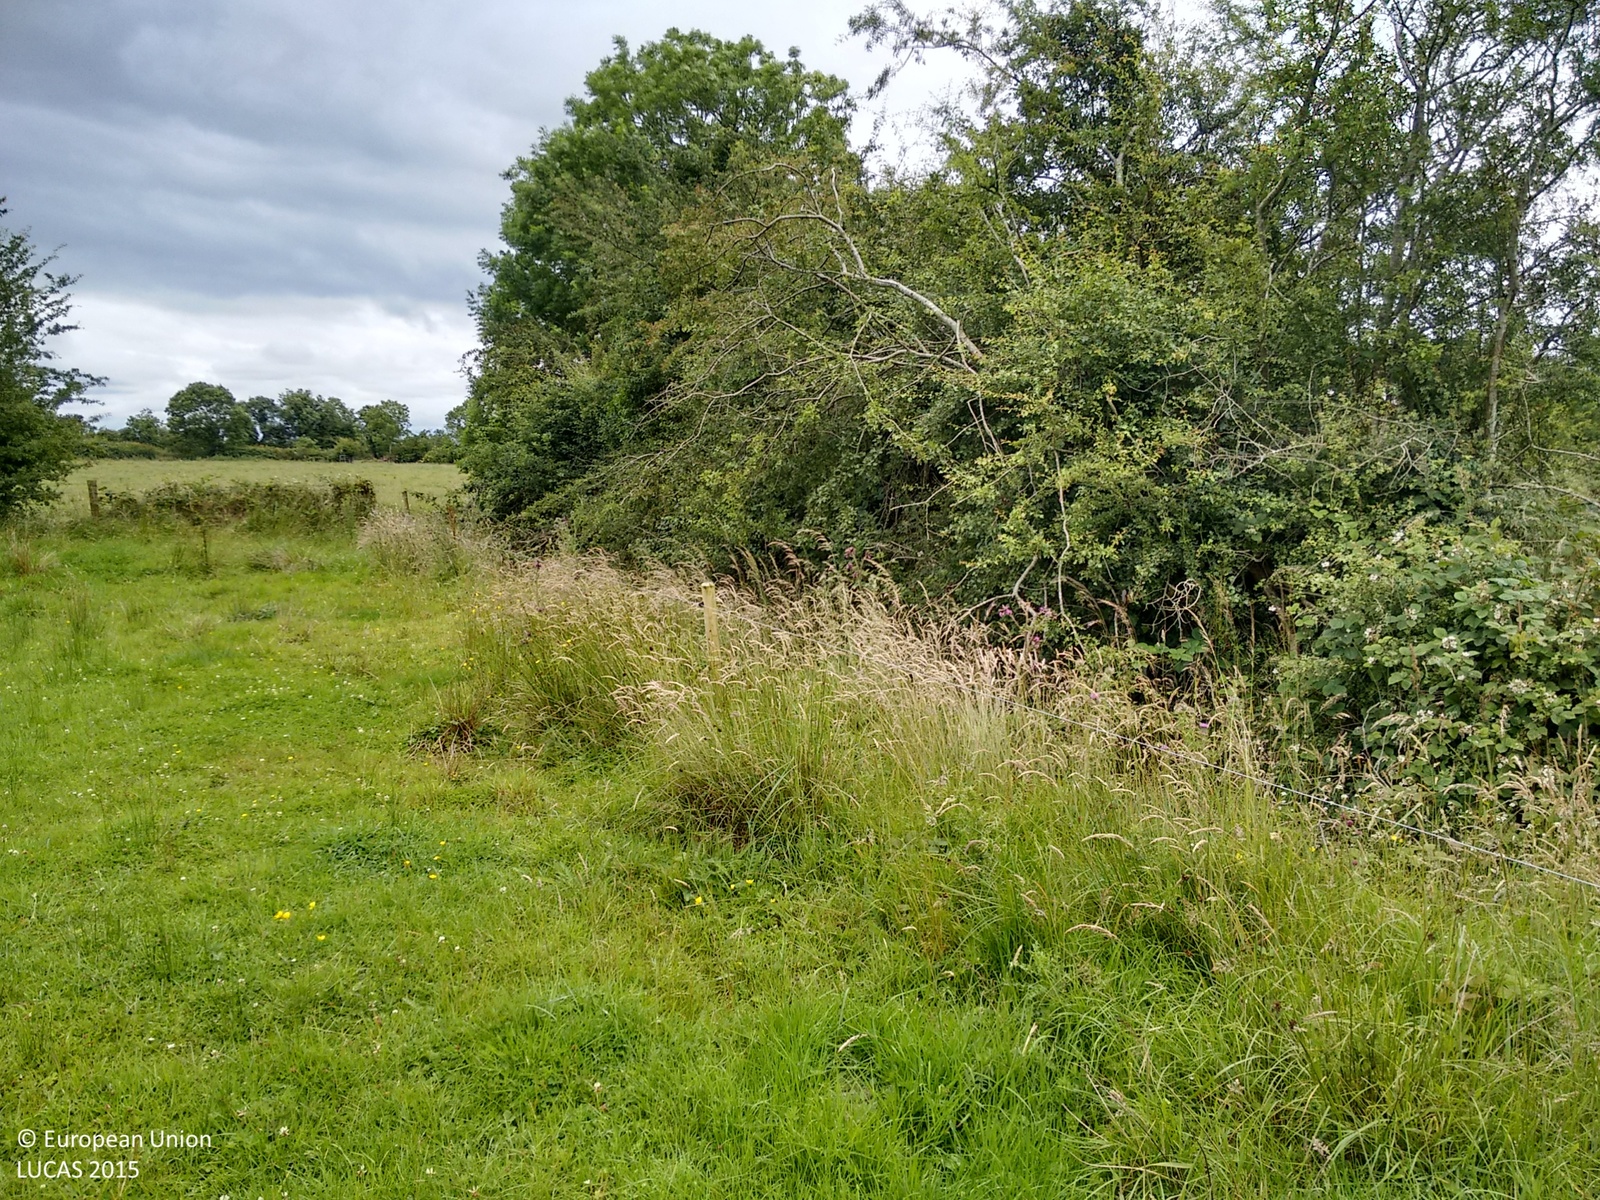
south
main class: Grassland
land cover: Grassland without tree/shrub cover
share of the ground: > 75 %
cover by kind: herbaceous plants 95 %, shrubs 5 %
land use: Agriculture (excluding fallow land and kitchen gardens)
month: July
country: IE
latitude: 53.6761
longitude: -7.6474
